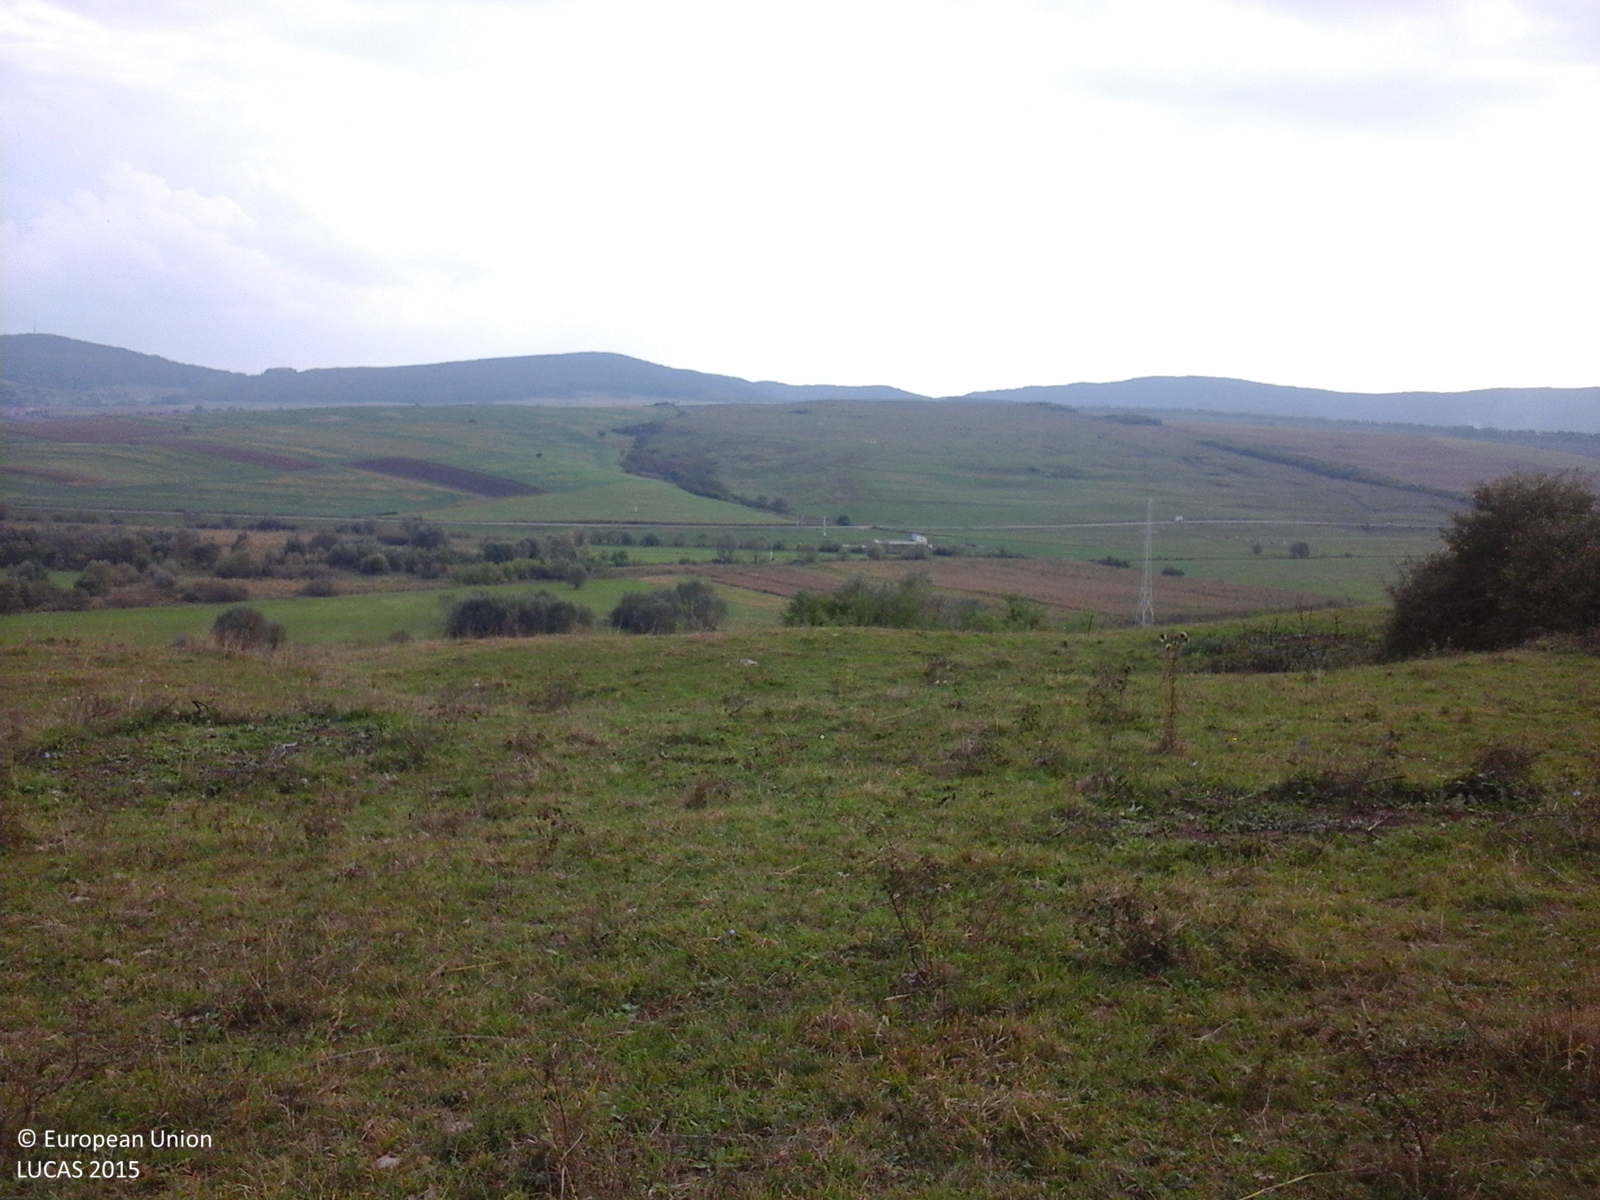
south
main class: Grassland
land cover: Grassland without tree/shrub cover
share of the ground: > 75 %
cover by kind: herbaceous plants 100 %
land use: Agriculture (excluding fallow land and kitchen gardens)
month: October
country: RO
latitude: 46.2247
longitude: 24.3035
